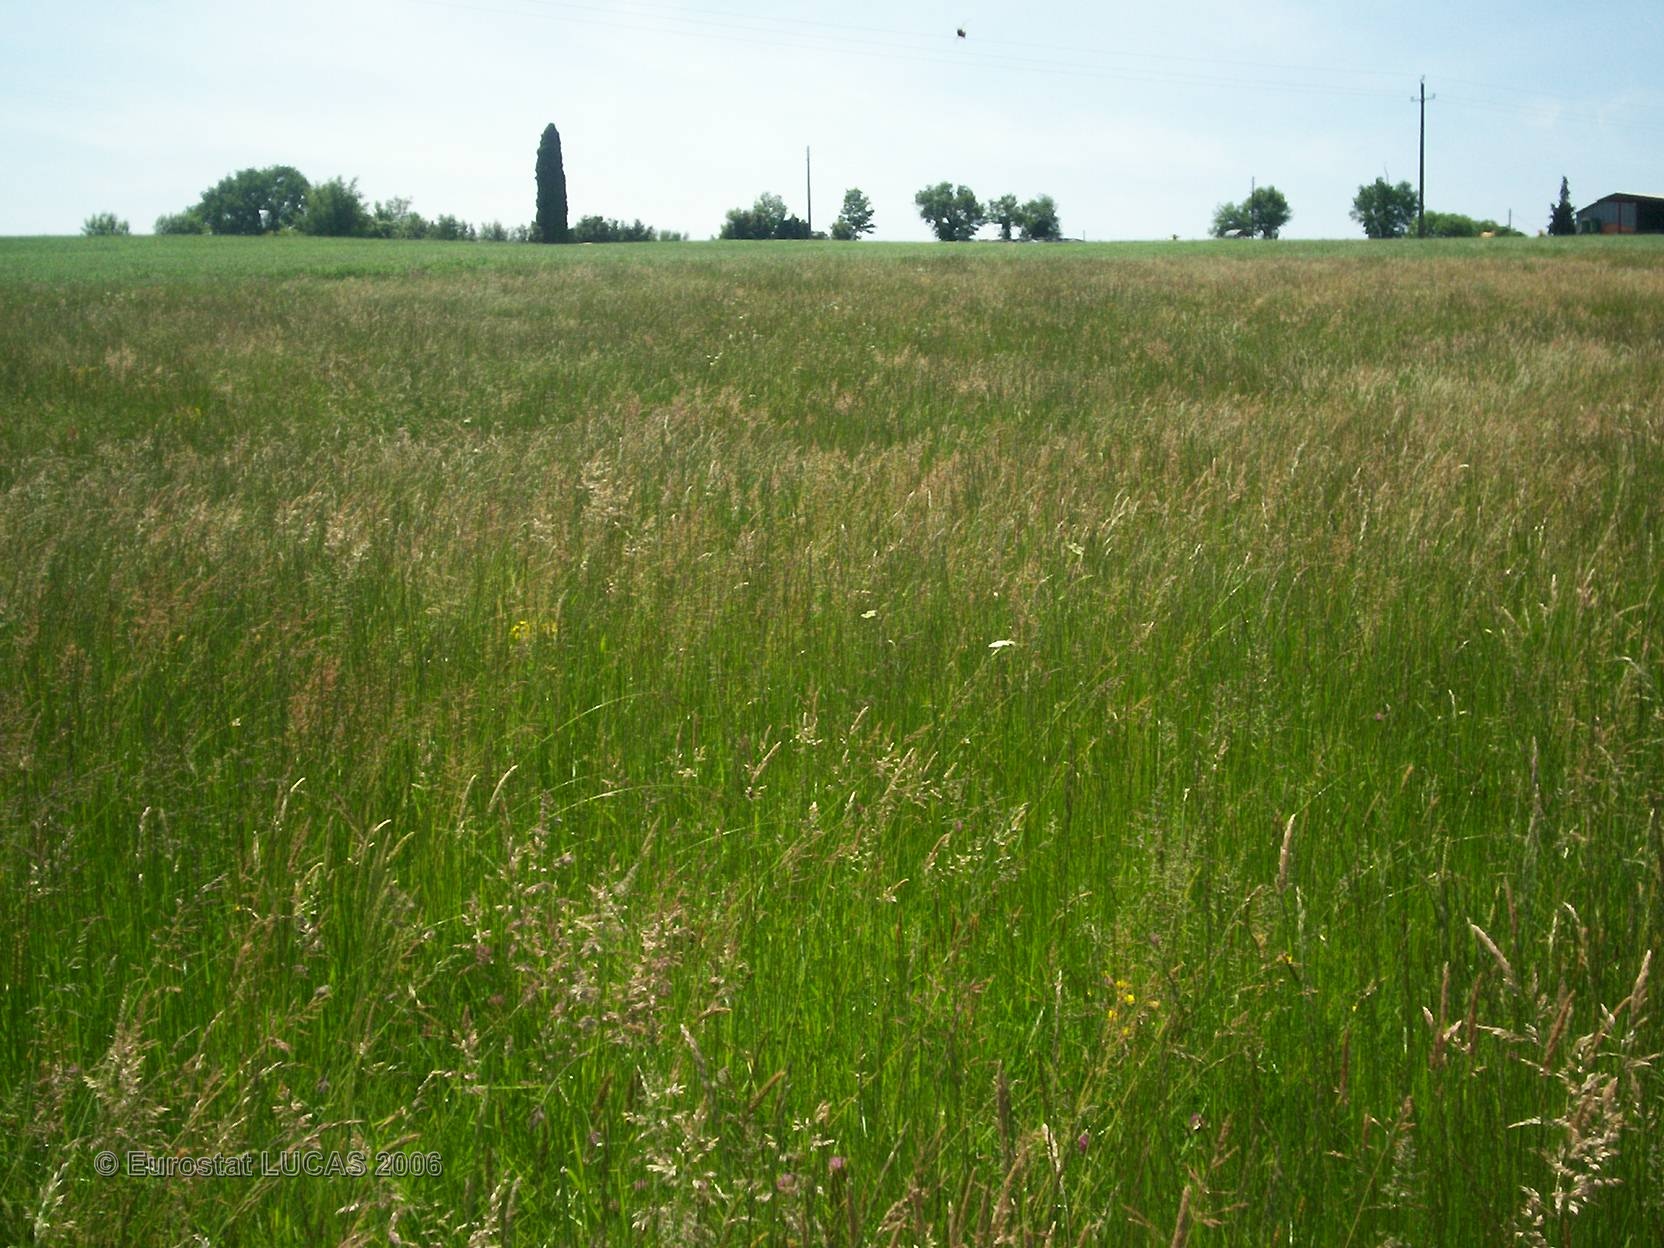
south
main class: Grassland
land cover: Grassland without tree/shrub cover
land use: Agriculture (excluding fallow land and kitchen gardens)
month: May
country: FR
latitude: 43.5646
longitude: 0.8504
